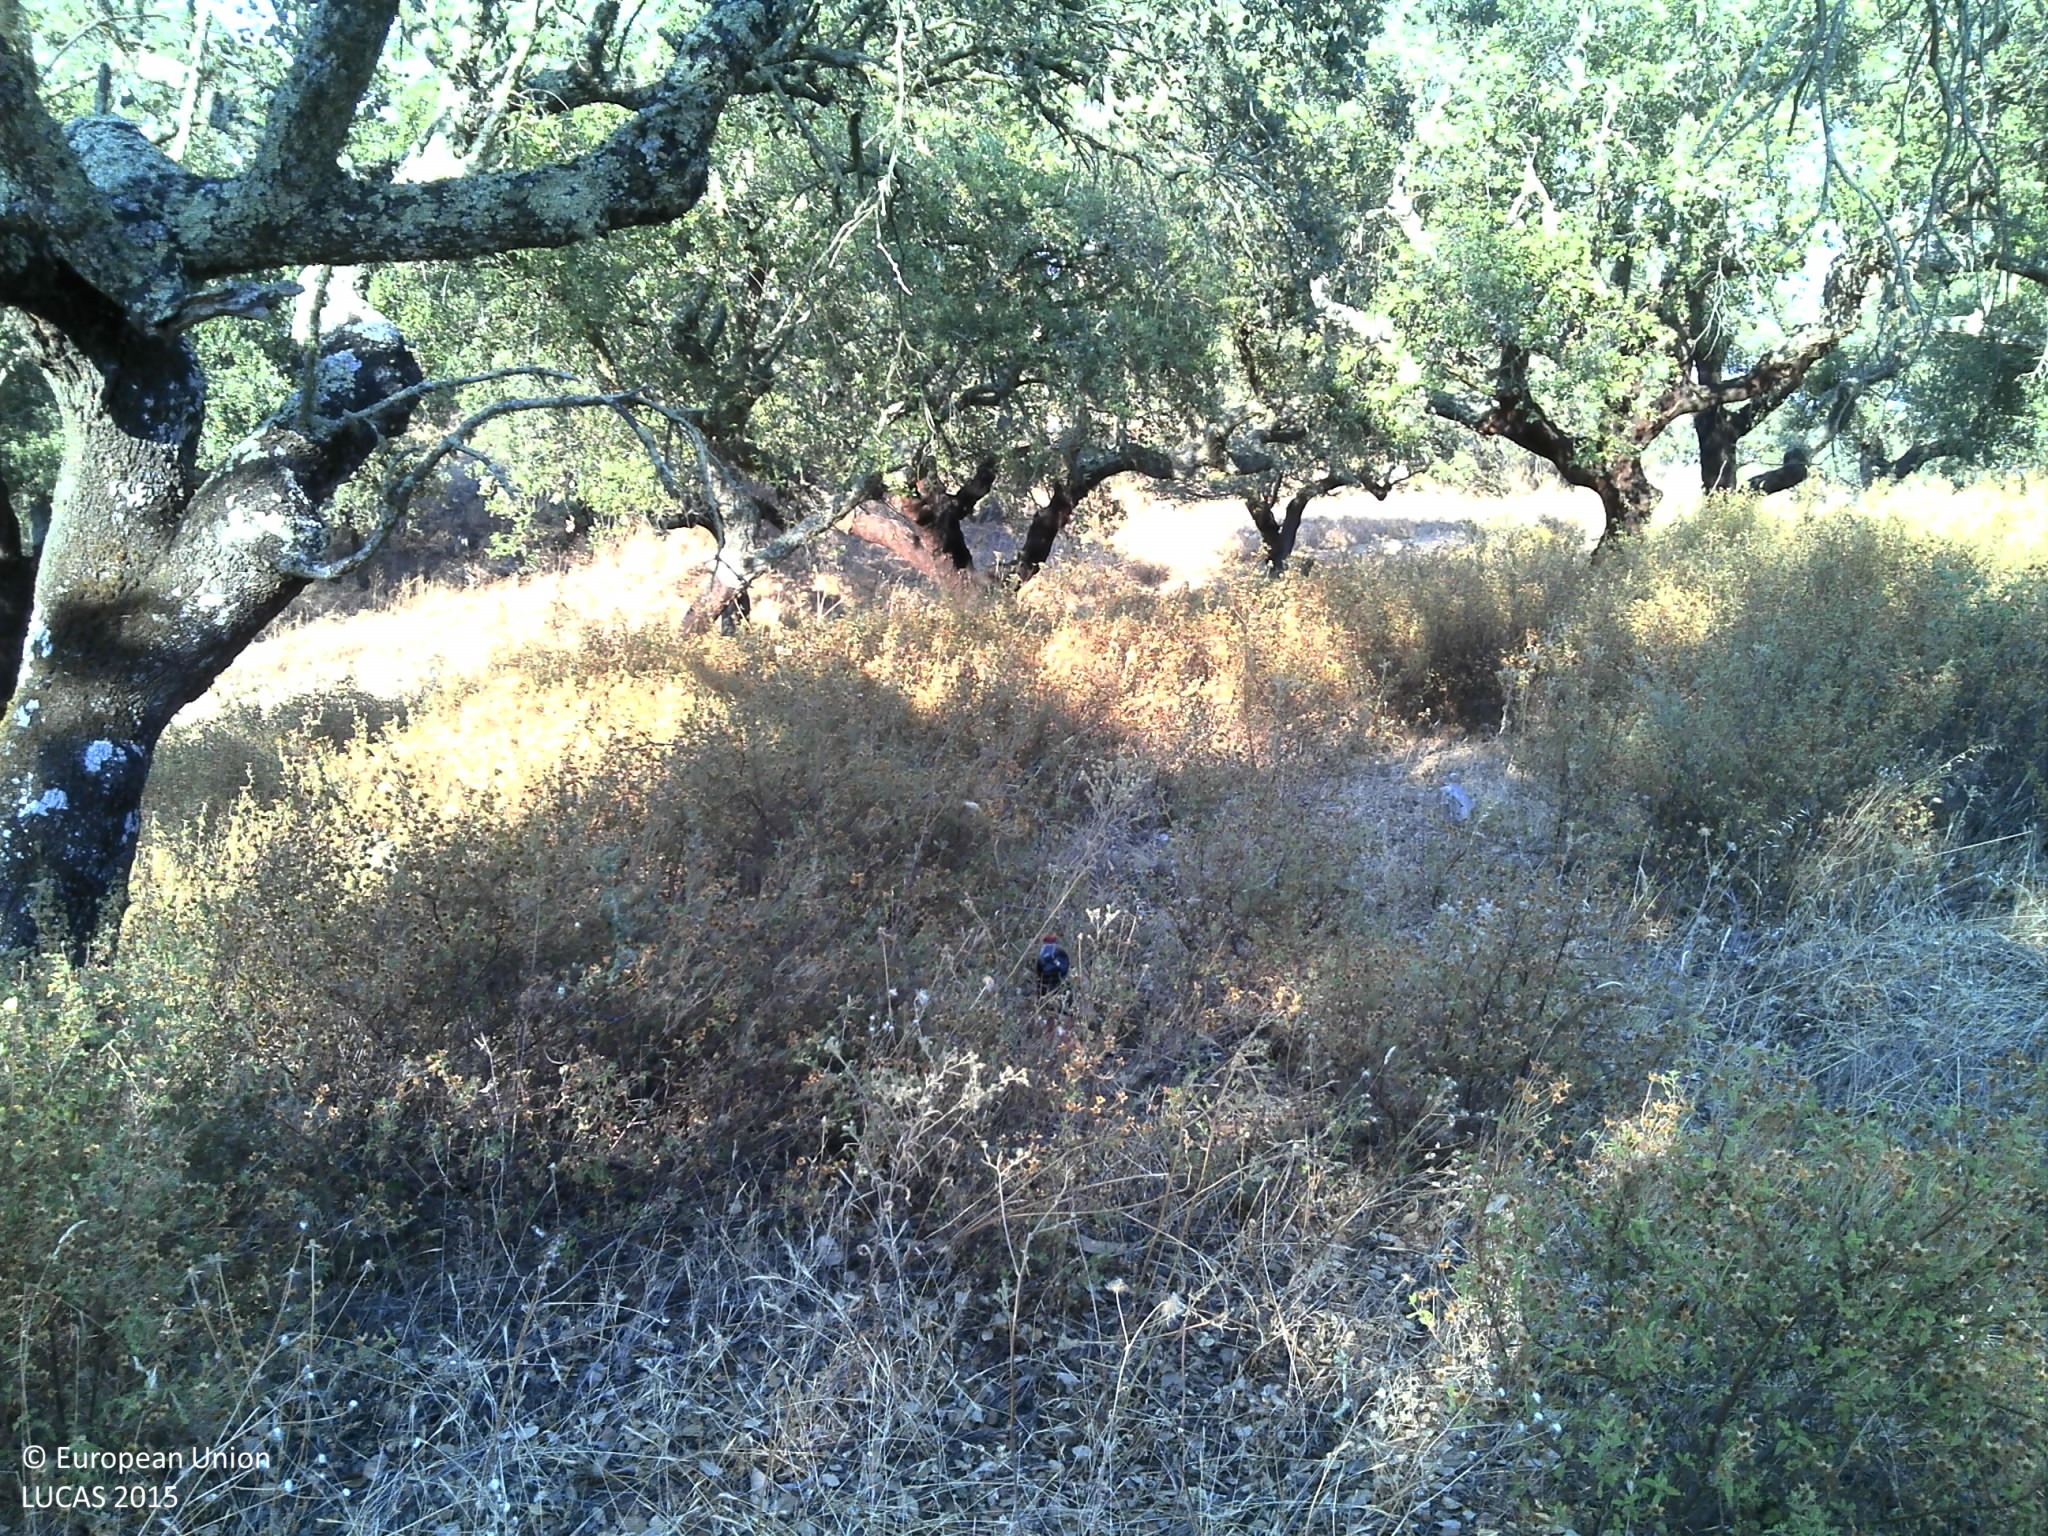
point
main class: Woodland
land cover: Broadleaved woodland
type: broadleaved evergreen forest
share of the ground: 50 - 75 %
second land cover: Grassland without tree/shrub cover
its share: 50 - 75 %
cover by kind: broadleaved forest trees 50 %, herbaceous plants 50 %
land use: Forestry
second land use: Agriculture (excluding fallow land and kitchen gardens)
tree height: > 5 m
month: June
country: PT
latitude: 38.3101
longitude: -7.6051
